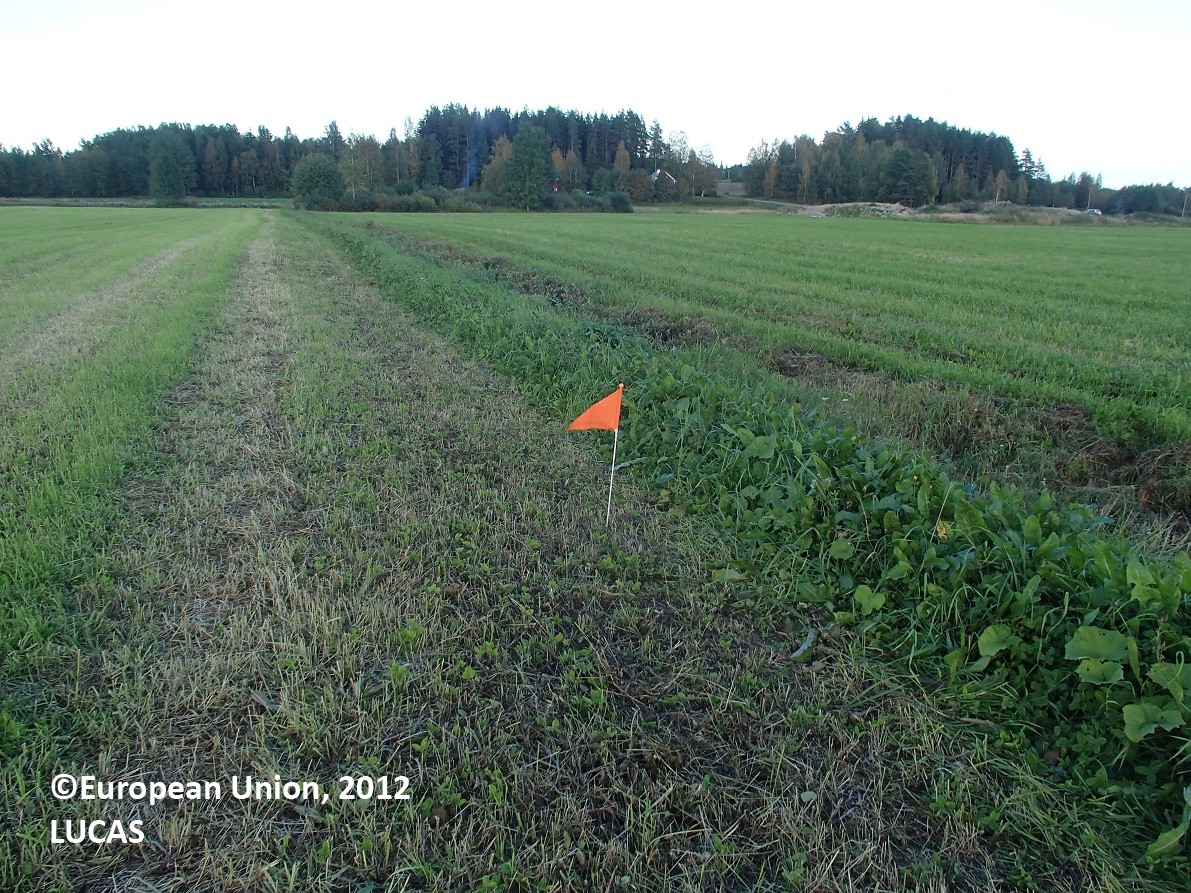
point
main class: Cropland
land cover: Temporary grasslands
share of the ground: > 75 %
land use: Agriculture (excluding fallow land and kitchen gardens)
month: August
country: FI
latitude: 63.5813
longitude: 27.0012
